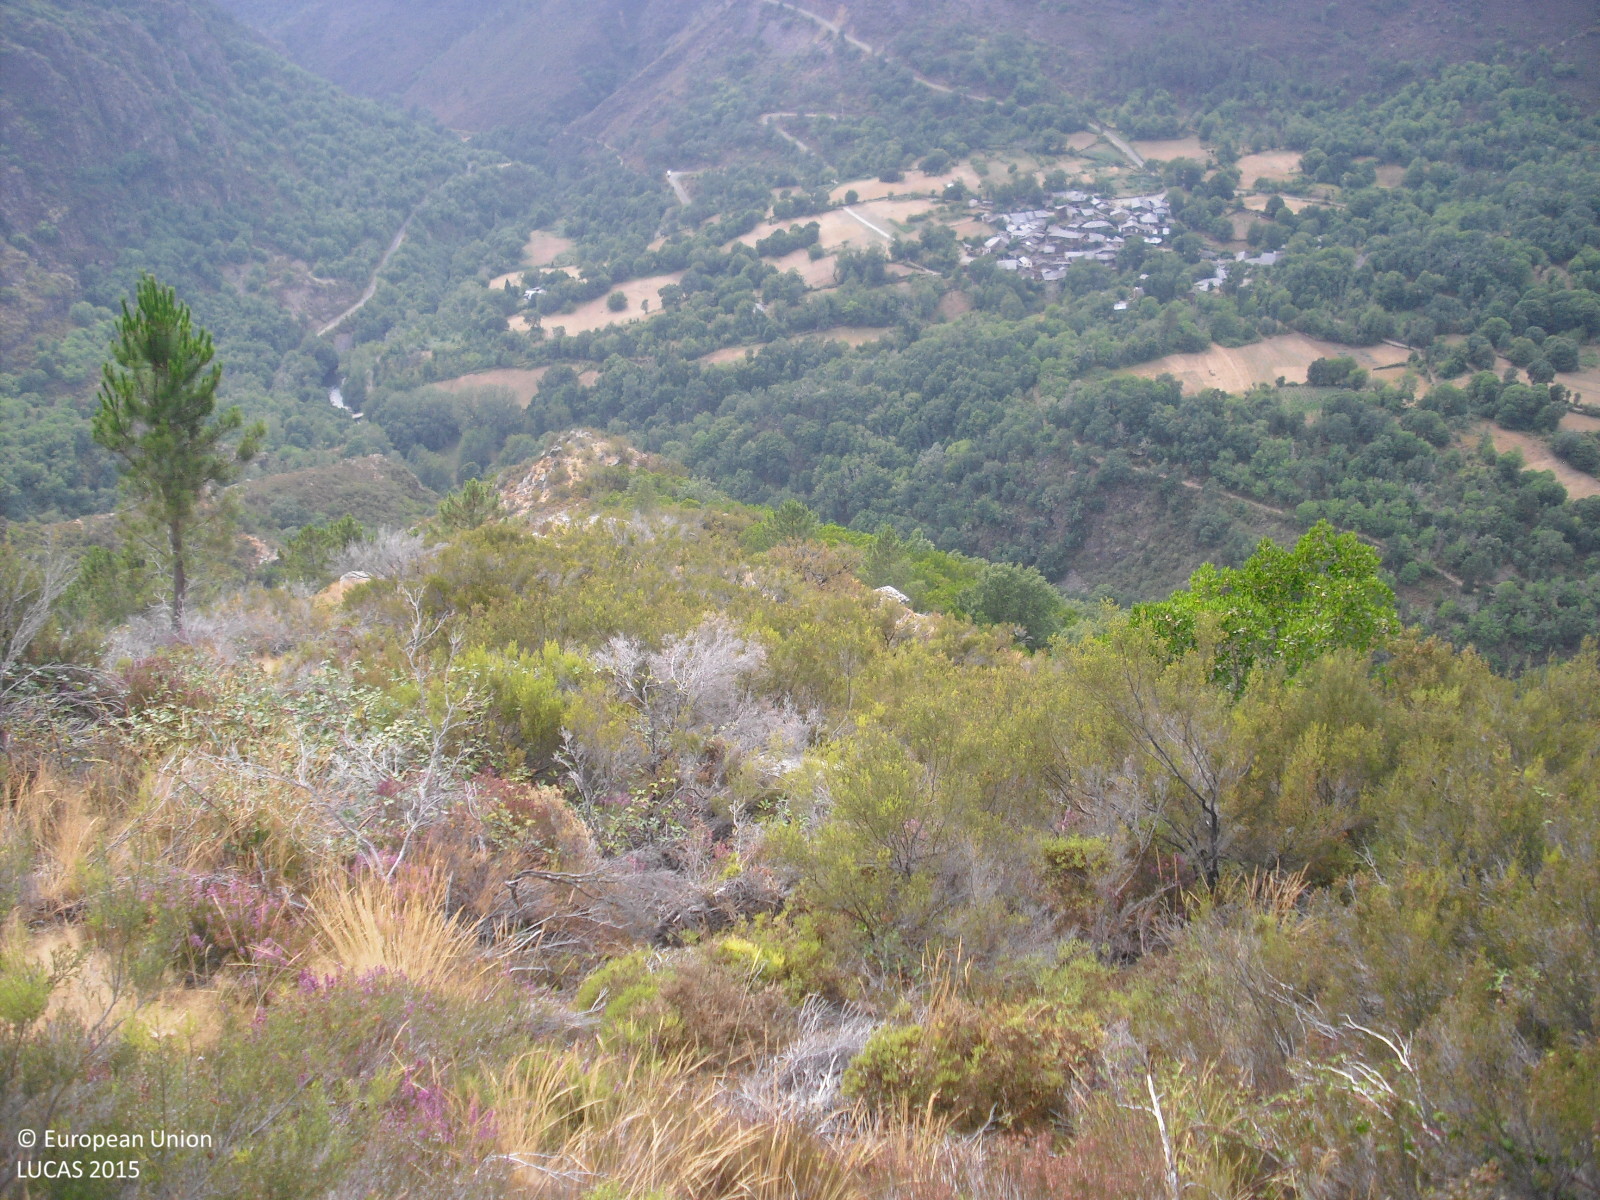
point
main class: Woodland
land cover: Pine dominated mixed woodland
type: hemiboreal forest and nemoral coniferous forest and mixed broadleaved-coniferous forest
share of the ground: 25 - 50 %
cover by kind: broadleaved forest trees 50 %, coniferous forest trees 30 %, consolidated bare surface 20 %
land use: Semi-natural and natural areas not in use
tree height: > 5 m
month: July
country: ES
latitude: 42.5435
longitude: -7.2446
